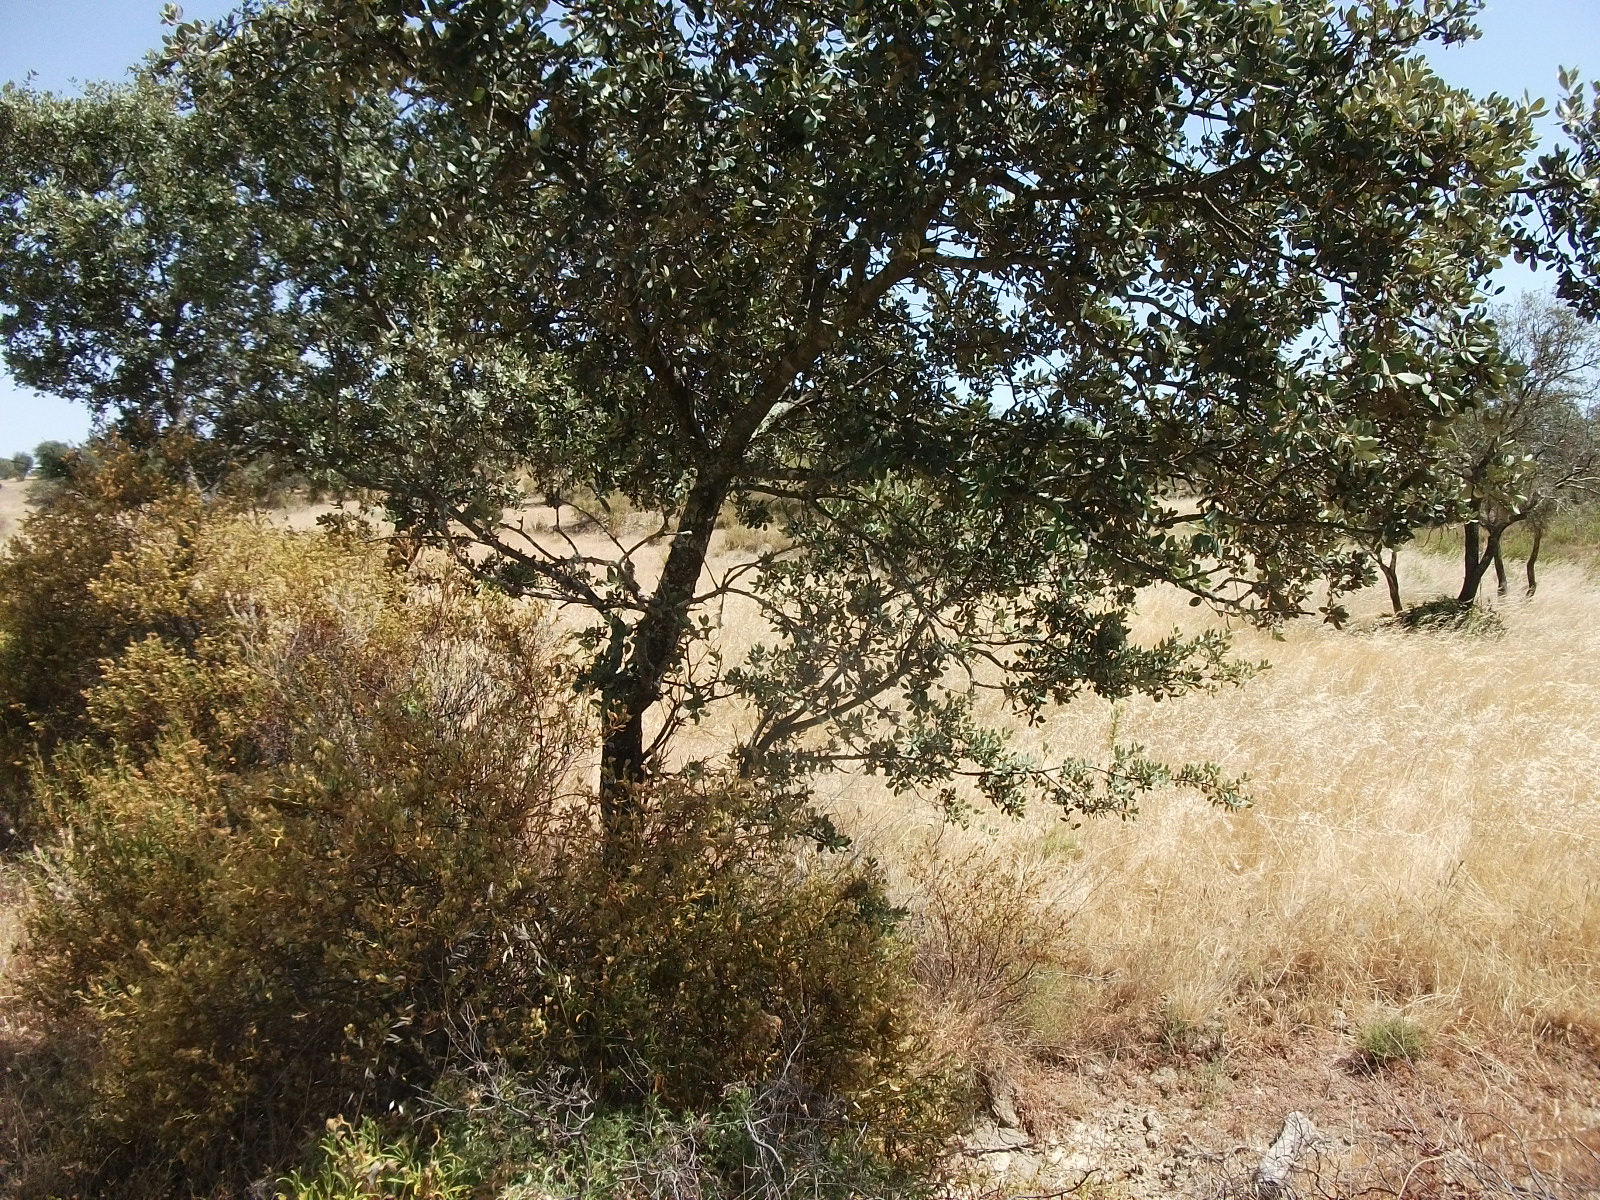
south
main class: Grassland
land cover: Grassland without tree/shrub cover
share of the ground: > 75 %
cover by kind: herbaceous plants 95 %, shrubs 5 %
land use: Agriculture (excluding fallow land and kitchen gardens)
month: June
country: ES
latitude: 37.5237
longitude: -6.9599
